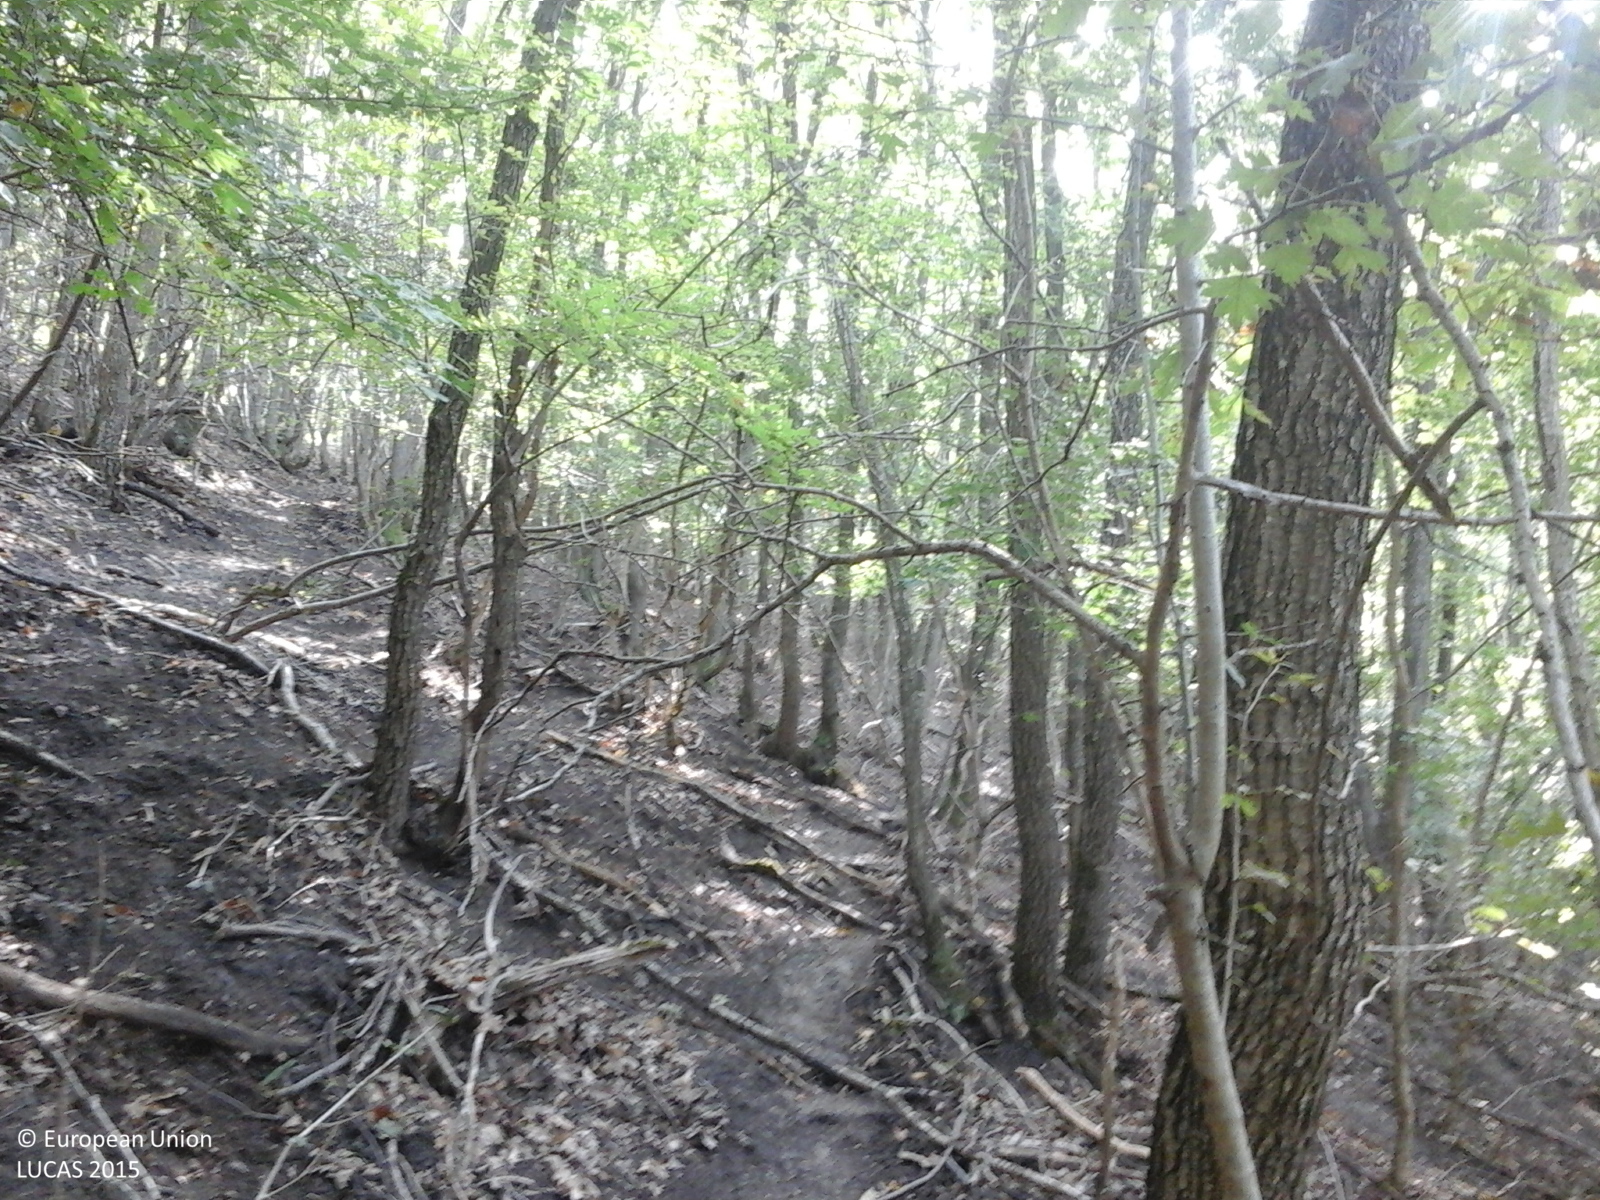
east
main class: Woodland
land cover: Broadleaved woodland
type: acidophilous oak and oak-birch forest
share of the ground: > 75 %
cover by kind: broadleaved forest trees 100 %
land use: Forestry
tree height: > 5 m
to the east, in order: Broadleaved woodland
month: September
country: RO
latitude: 47.0883
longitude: 23.7090
